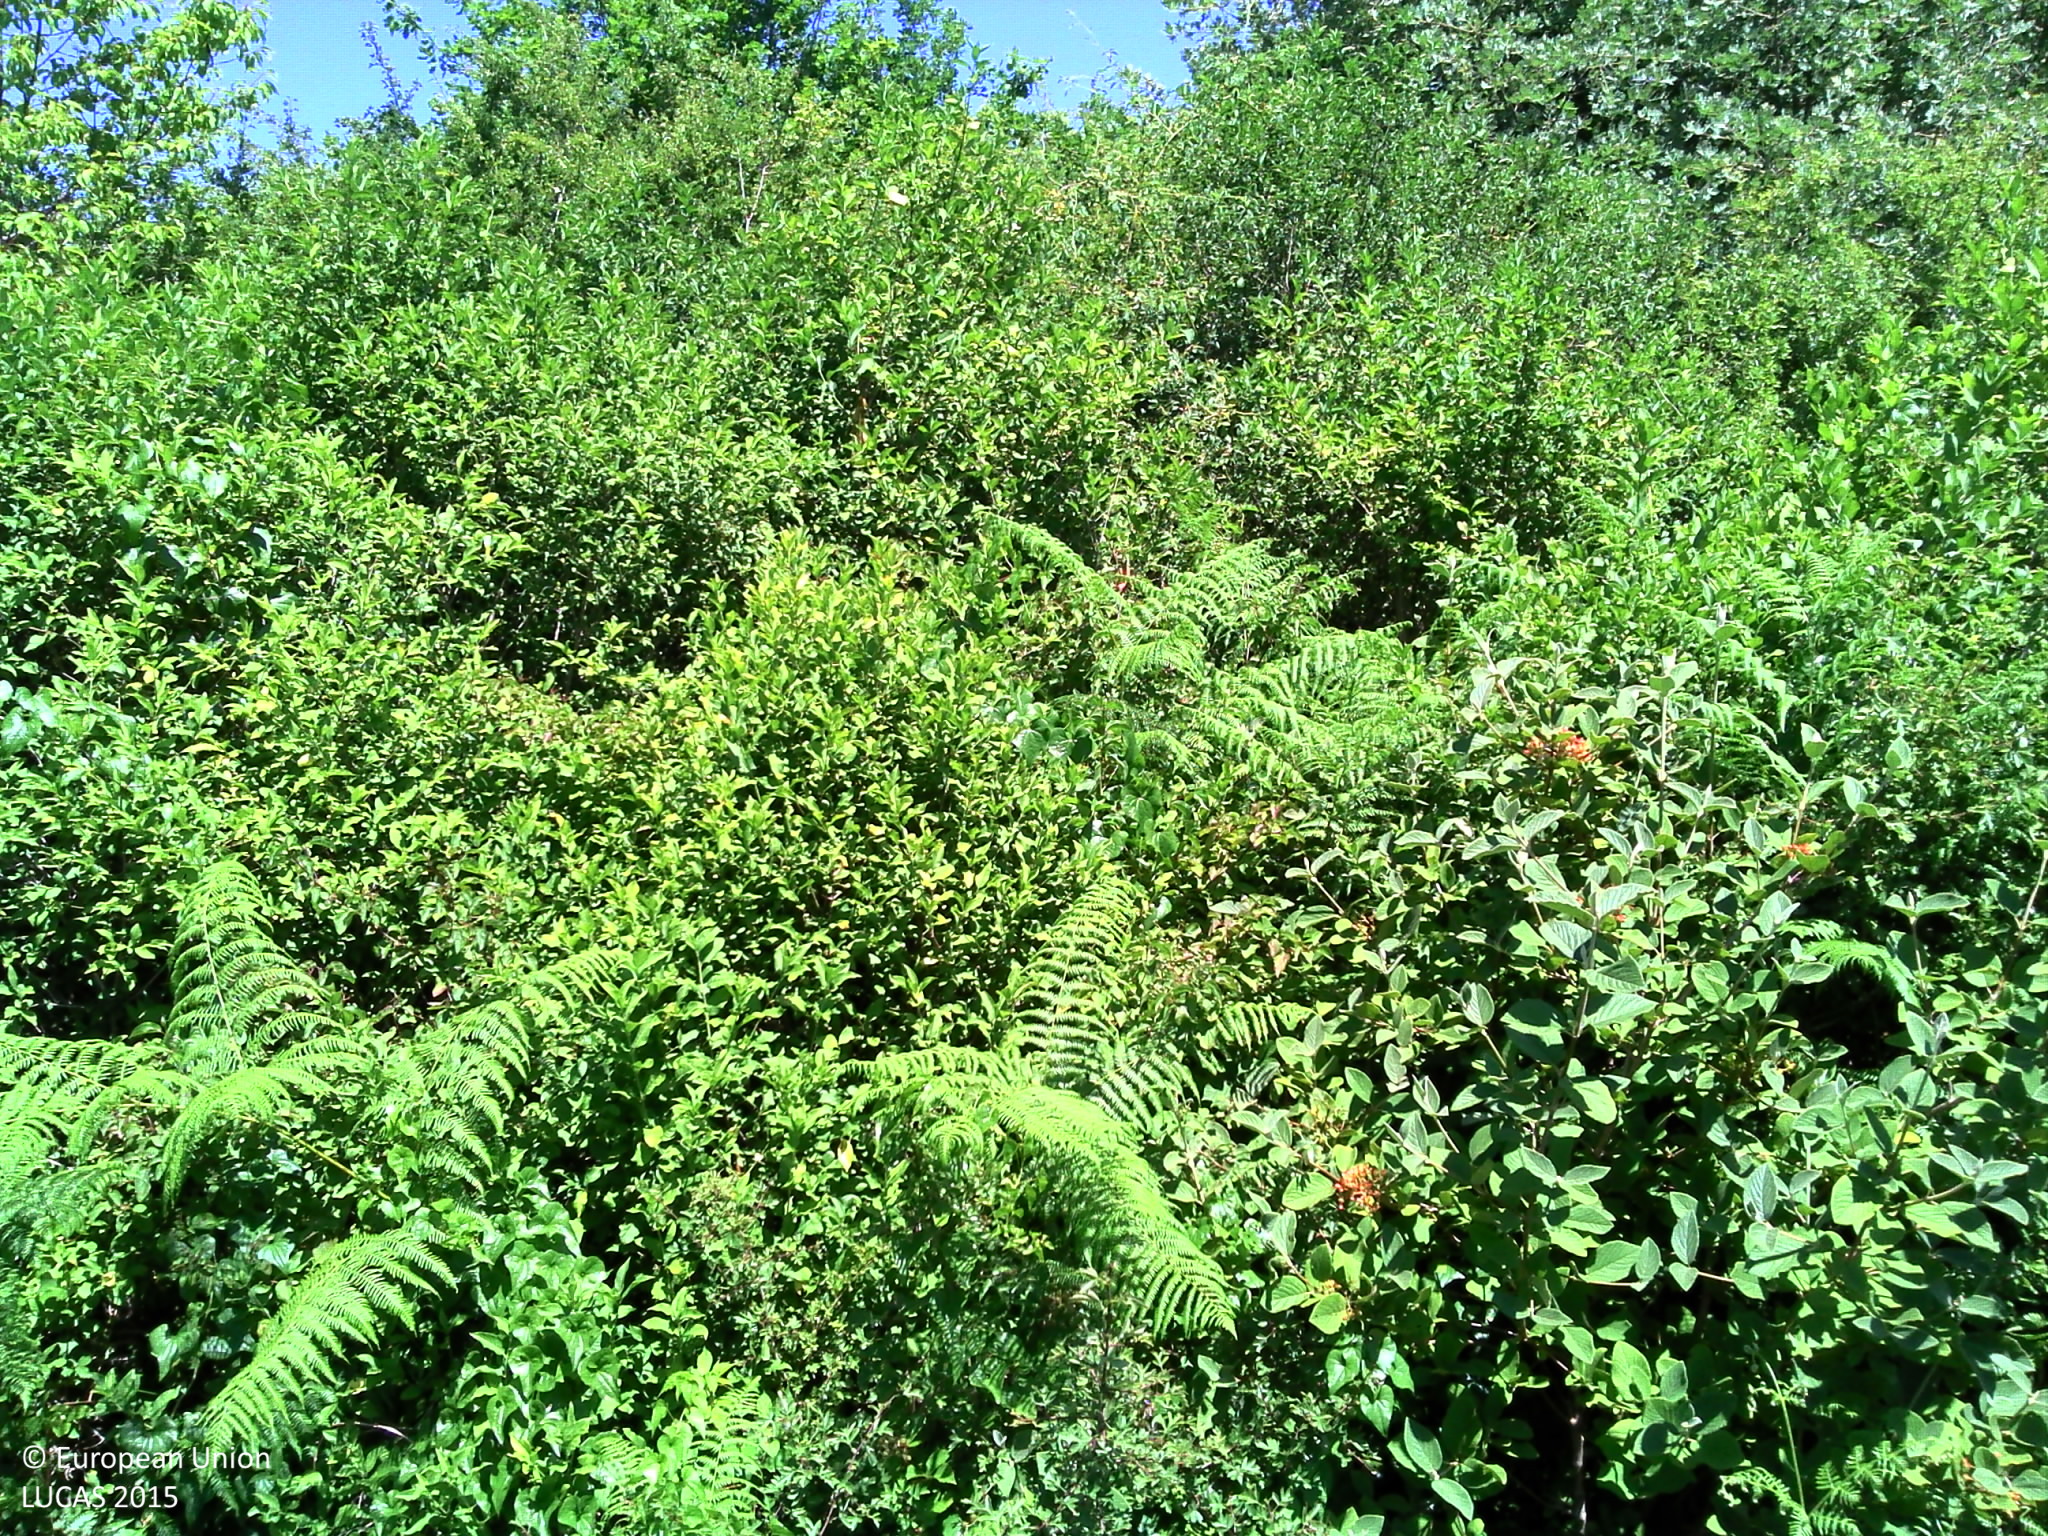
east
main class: Woodland
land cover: Broadleaved woodland
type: thermophilous deciduous forest
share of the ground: > 75 %
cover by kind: broadleaved forest trees 90 %, herbaceous plants 10 %
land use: Forestry
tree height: > 5 m
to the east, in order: Broadleaved woodland
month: June
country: FR
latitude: 45.5798
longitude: 0.4643
